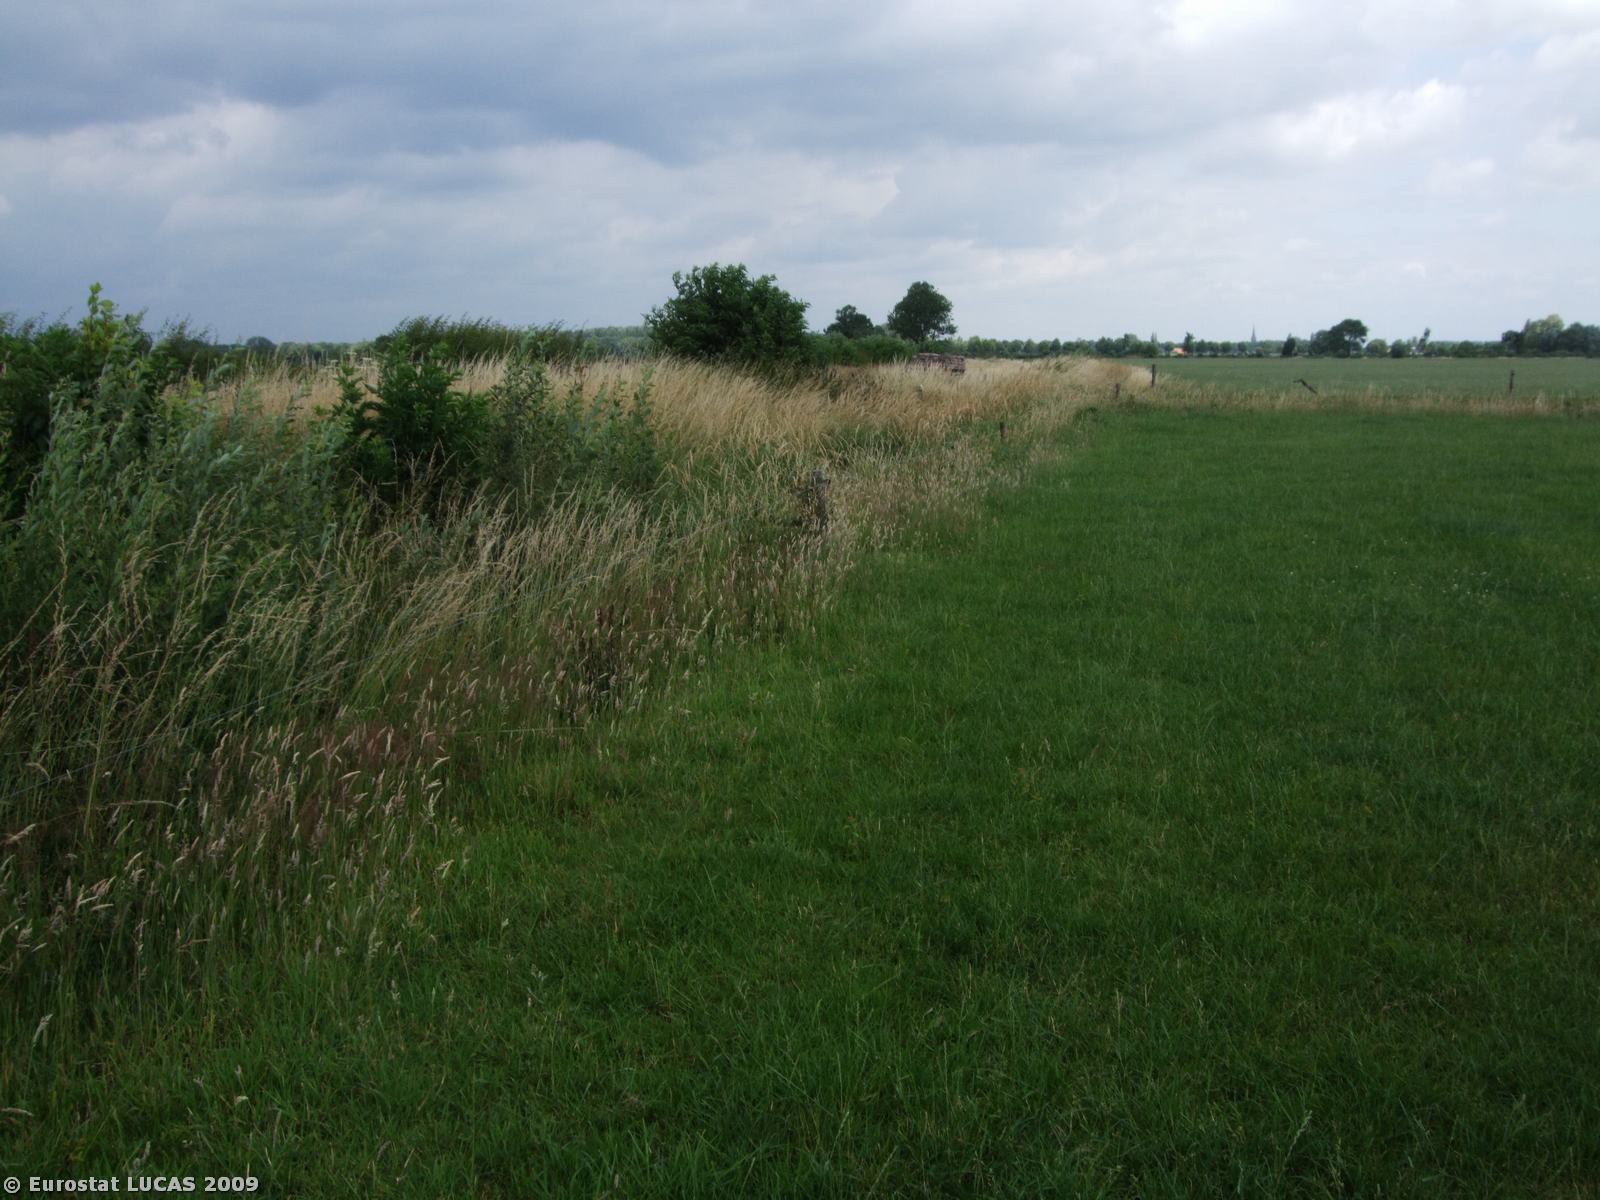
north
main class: Grassland
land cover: Grassland without tree/shrub cover
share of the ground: > 75 %
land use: Agriculture (excluding fallow land and kitchen gardens)
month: July
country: NL
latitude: 51.9719
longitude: 6.1126
